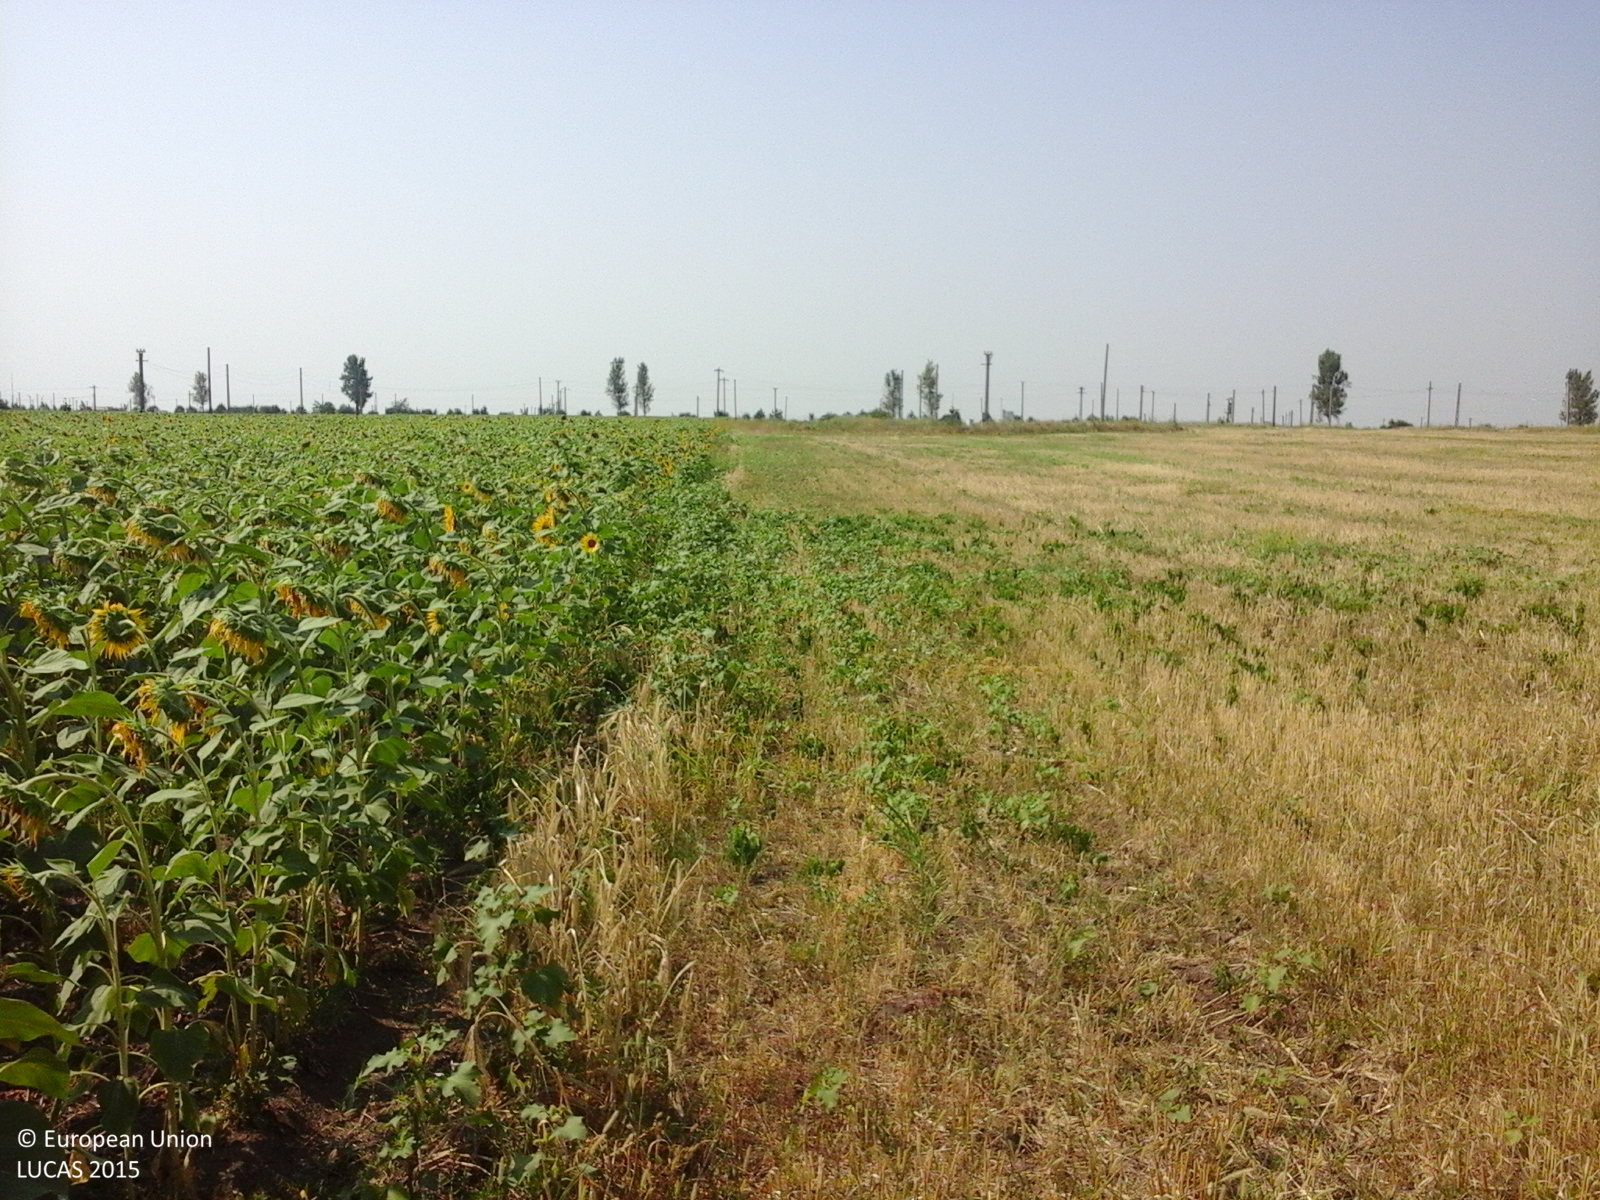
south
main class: Cropland
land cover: Sunflower
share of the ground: > 75 %
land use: Agriculture (excluding fallow land and kitchen gardens)
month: July
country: RO
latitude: 45.5605
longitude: 27.8046
